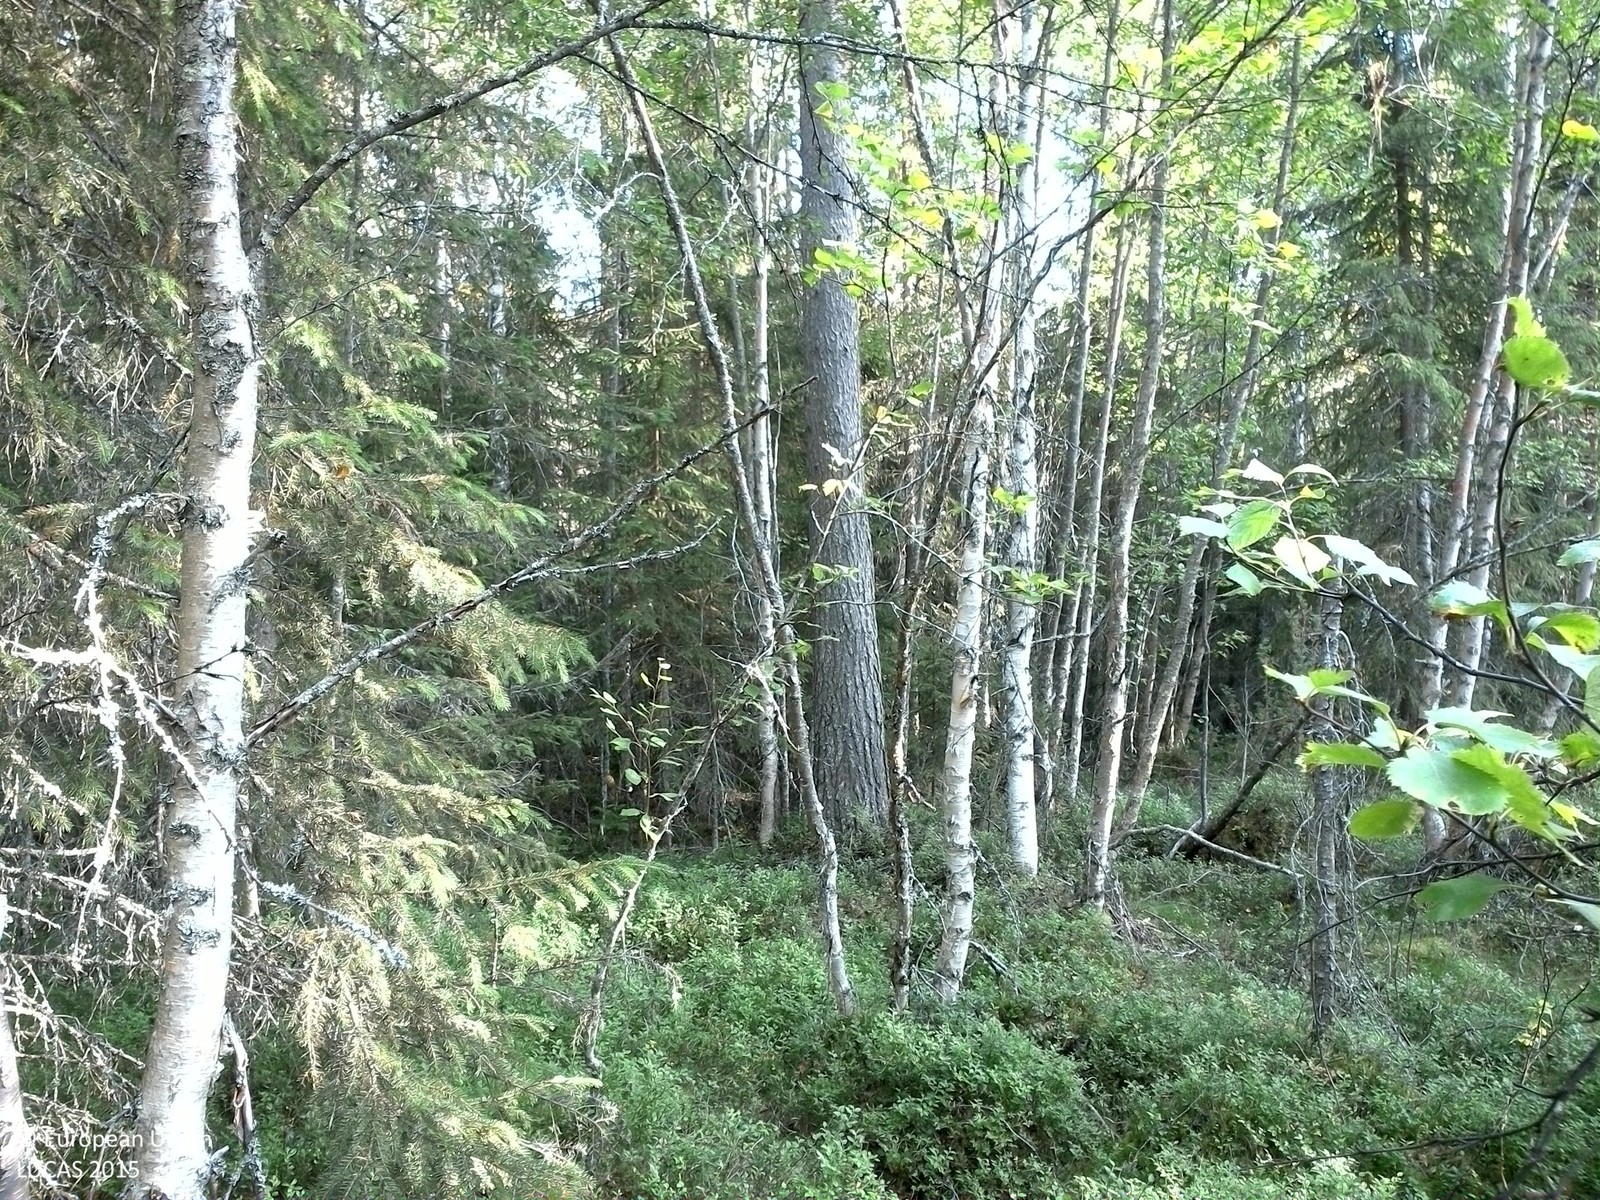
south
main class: Woodland
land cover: Other mixed woodland
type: boreal forest
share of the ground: > 75 %
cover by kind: coniferous forest trees 40 %, broadleaved forest trees 35 %, shrubs 20 %, lichens and mosses 5 %
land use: Forestry
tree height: > 5 m
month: August
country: SE
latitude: 63.8627
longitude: 17.3978
